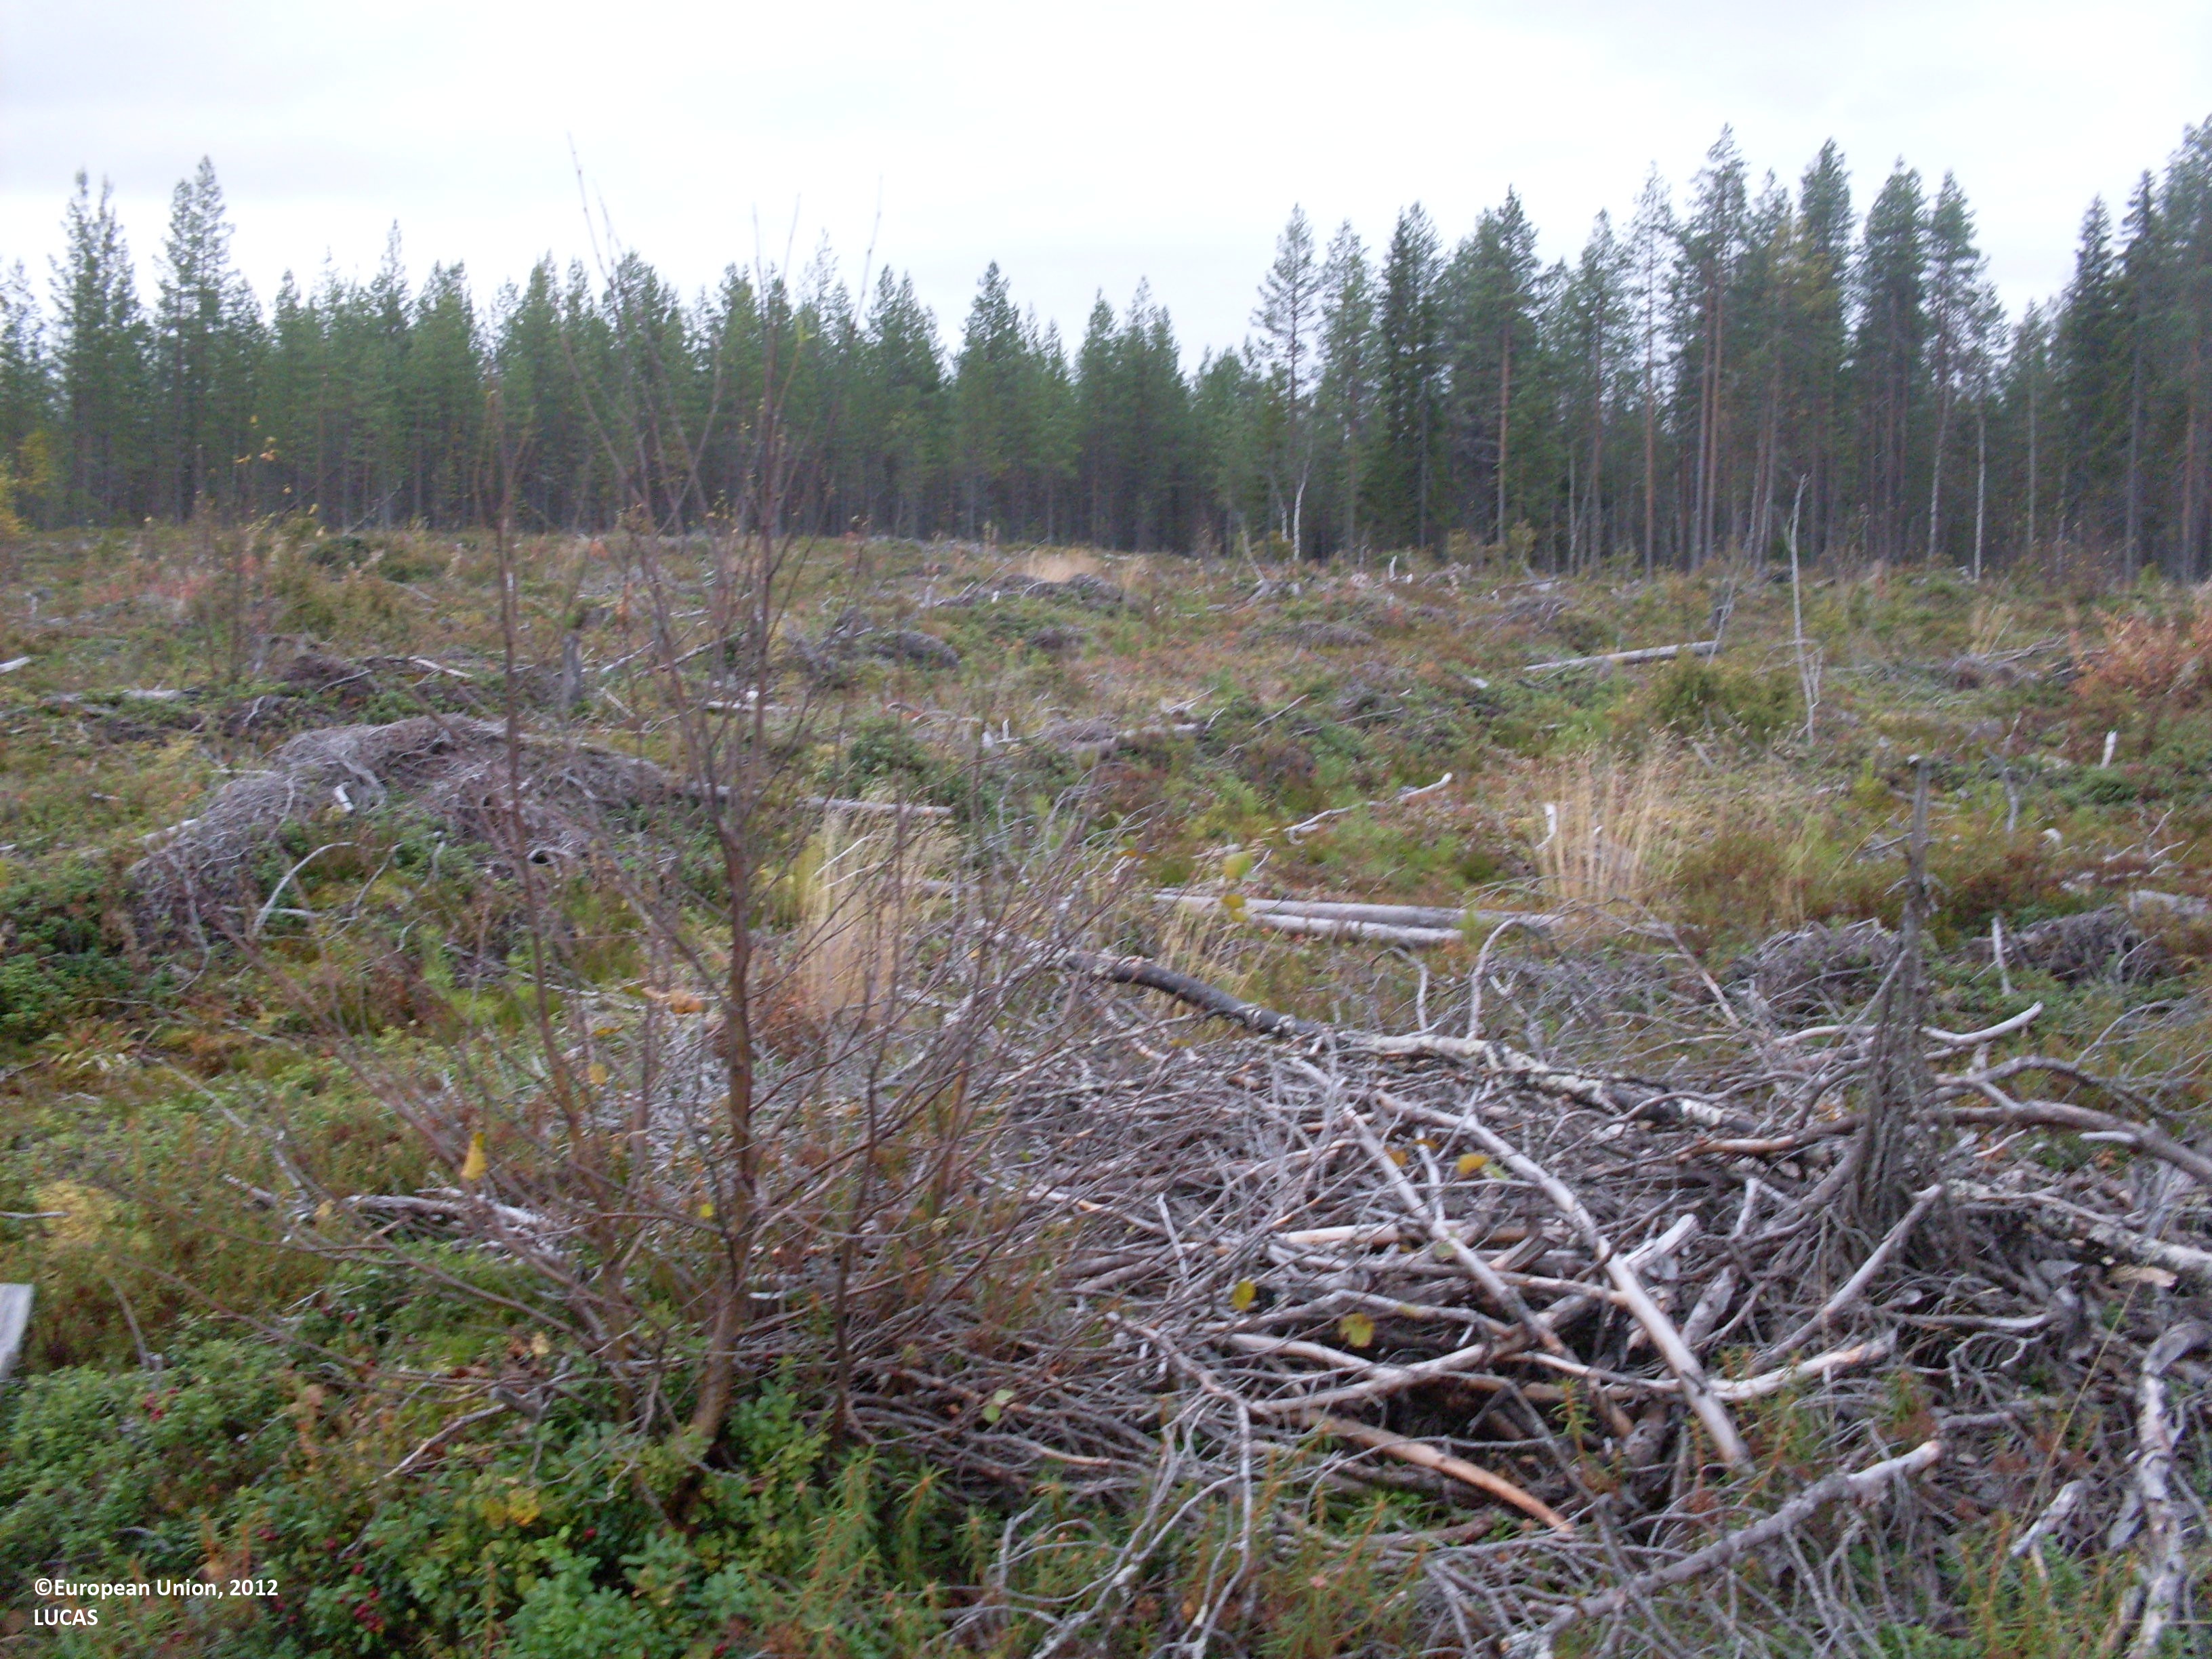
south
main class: Shrubland
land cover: Shrubland with sparse tree cover
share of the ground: > 75 %
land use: Forestry
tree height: < 5 m
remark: Clear cut
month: September
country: FI
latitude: 64.2601
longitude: 29.9010
